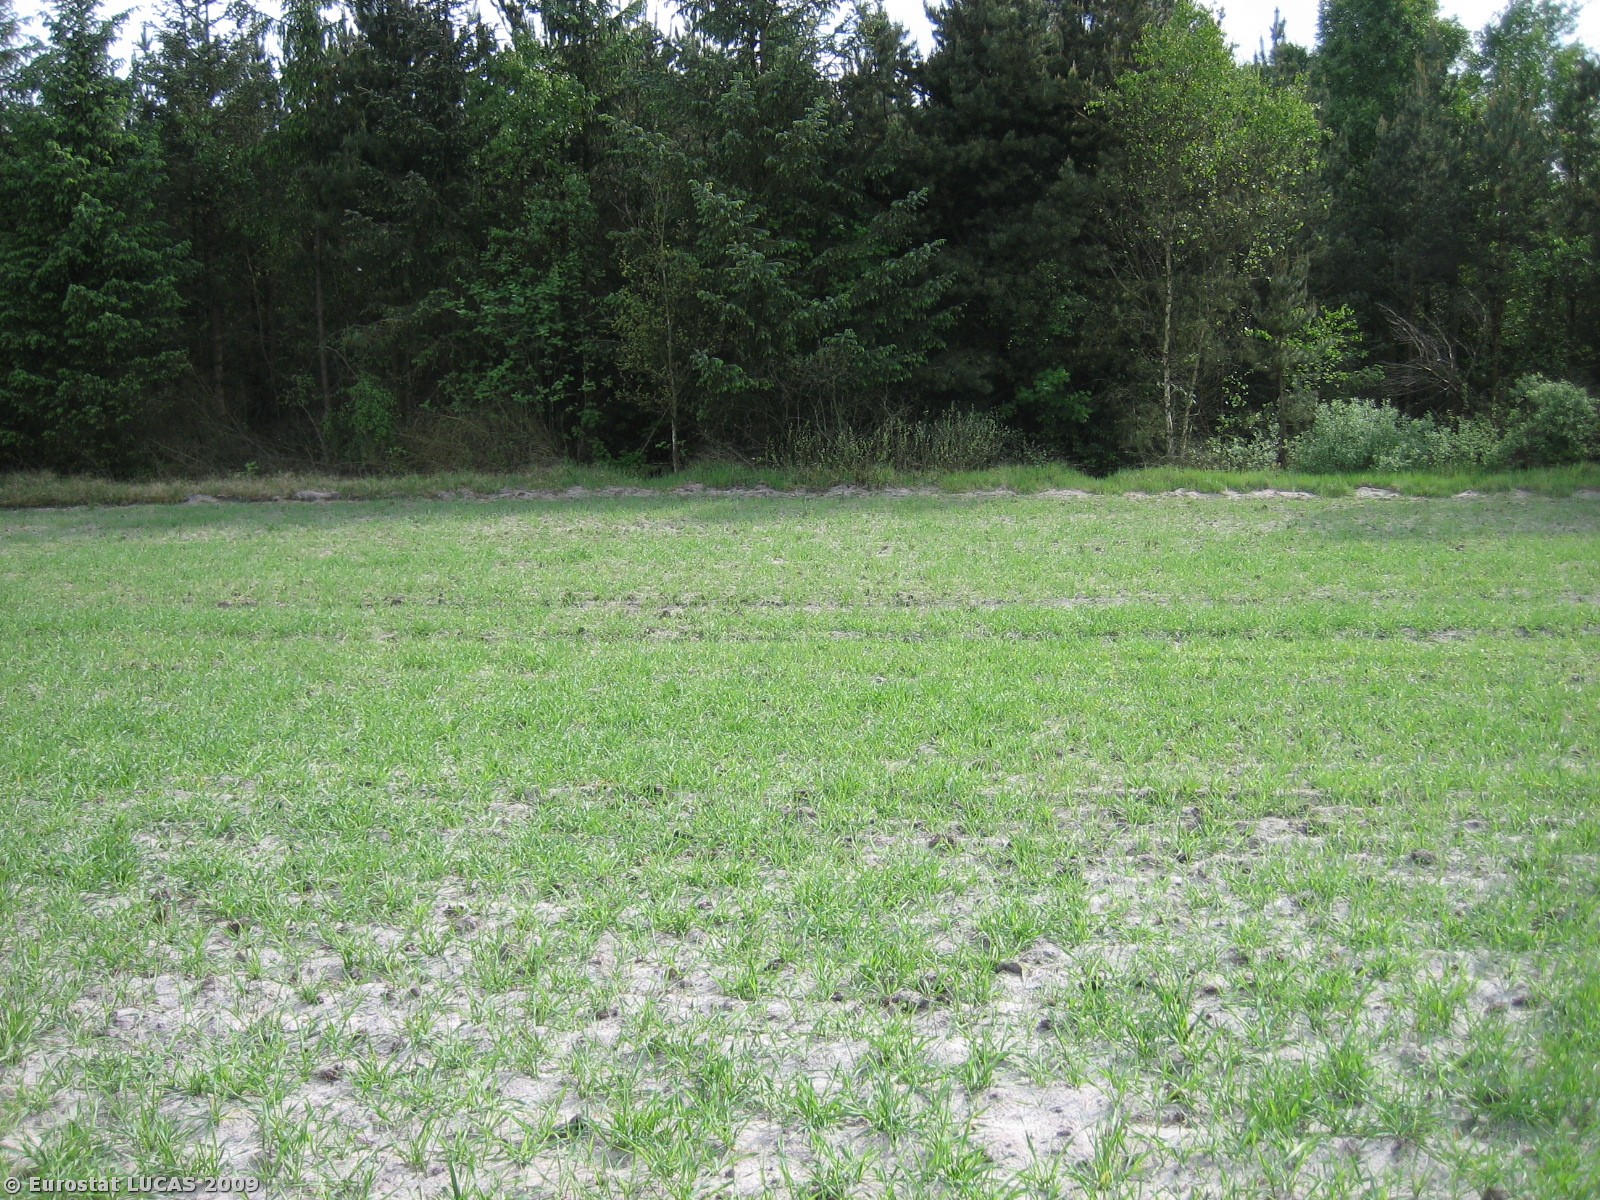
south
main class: Cropland
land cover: Barley
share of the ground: 25 - 50 %
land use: Agriculture (excluding fallow land and kitchen gardens)
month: May
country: DK
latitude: 56.2213
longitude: 9.2107
